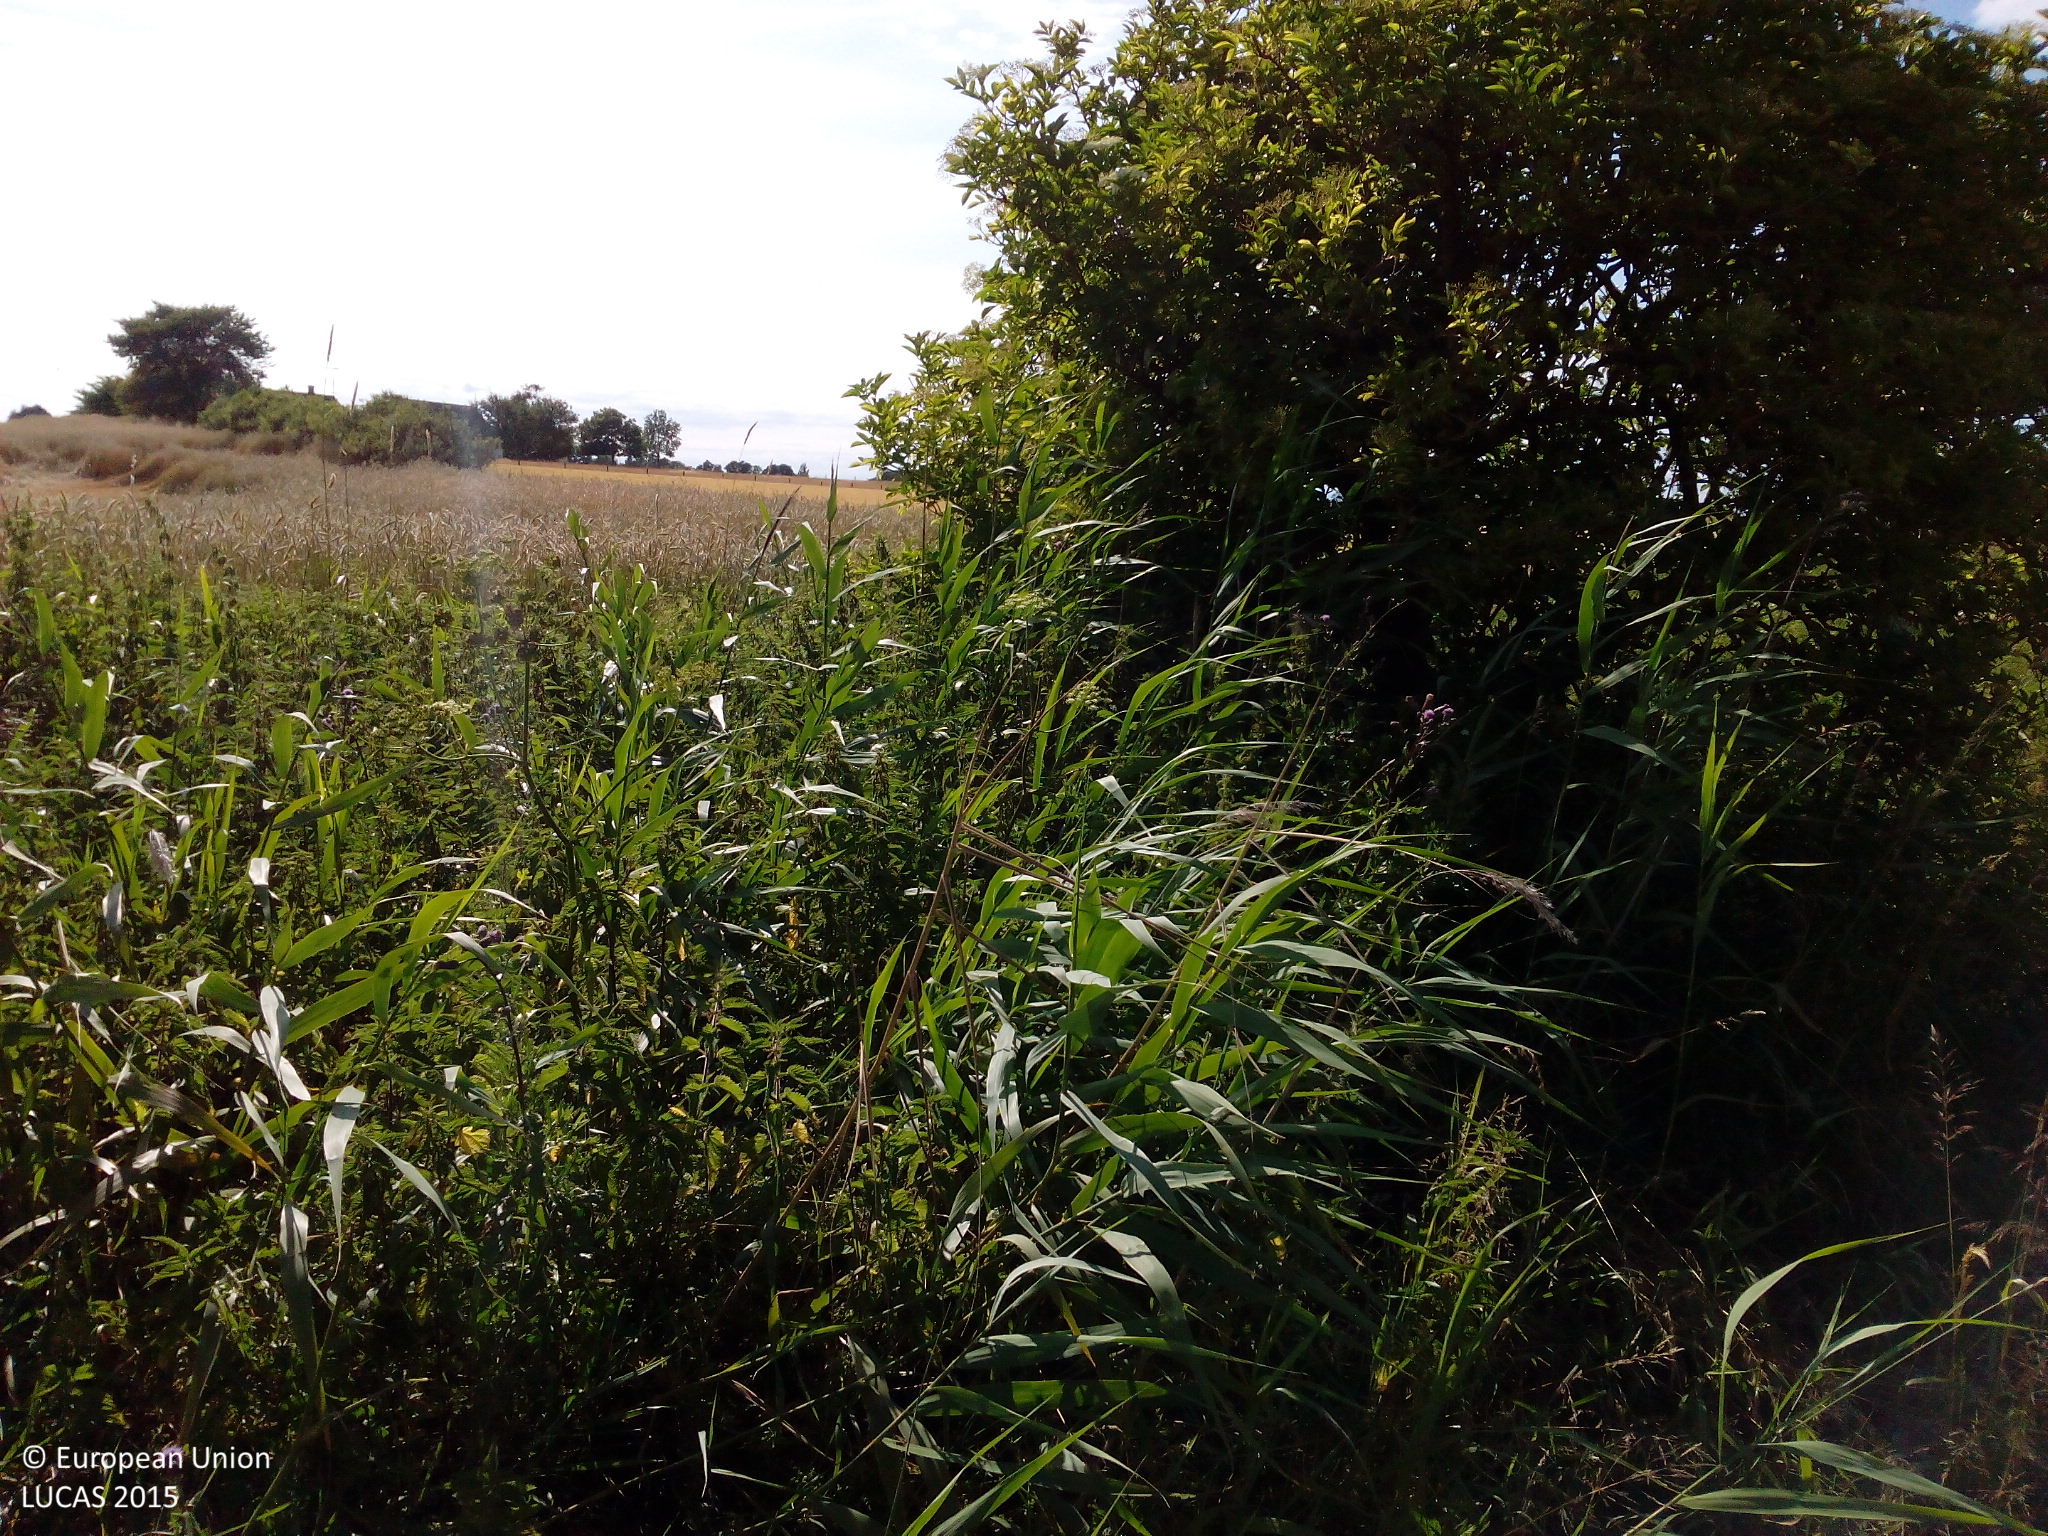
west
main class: Cropland
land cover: Rape and turnip rape
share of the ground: > 75 %
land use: Agriculture (excluding fallow land and kitchen gardens)
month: July
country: DK
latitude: 55.9749
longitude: 11.9691
